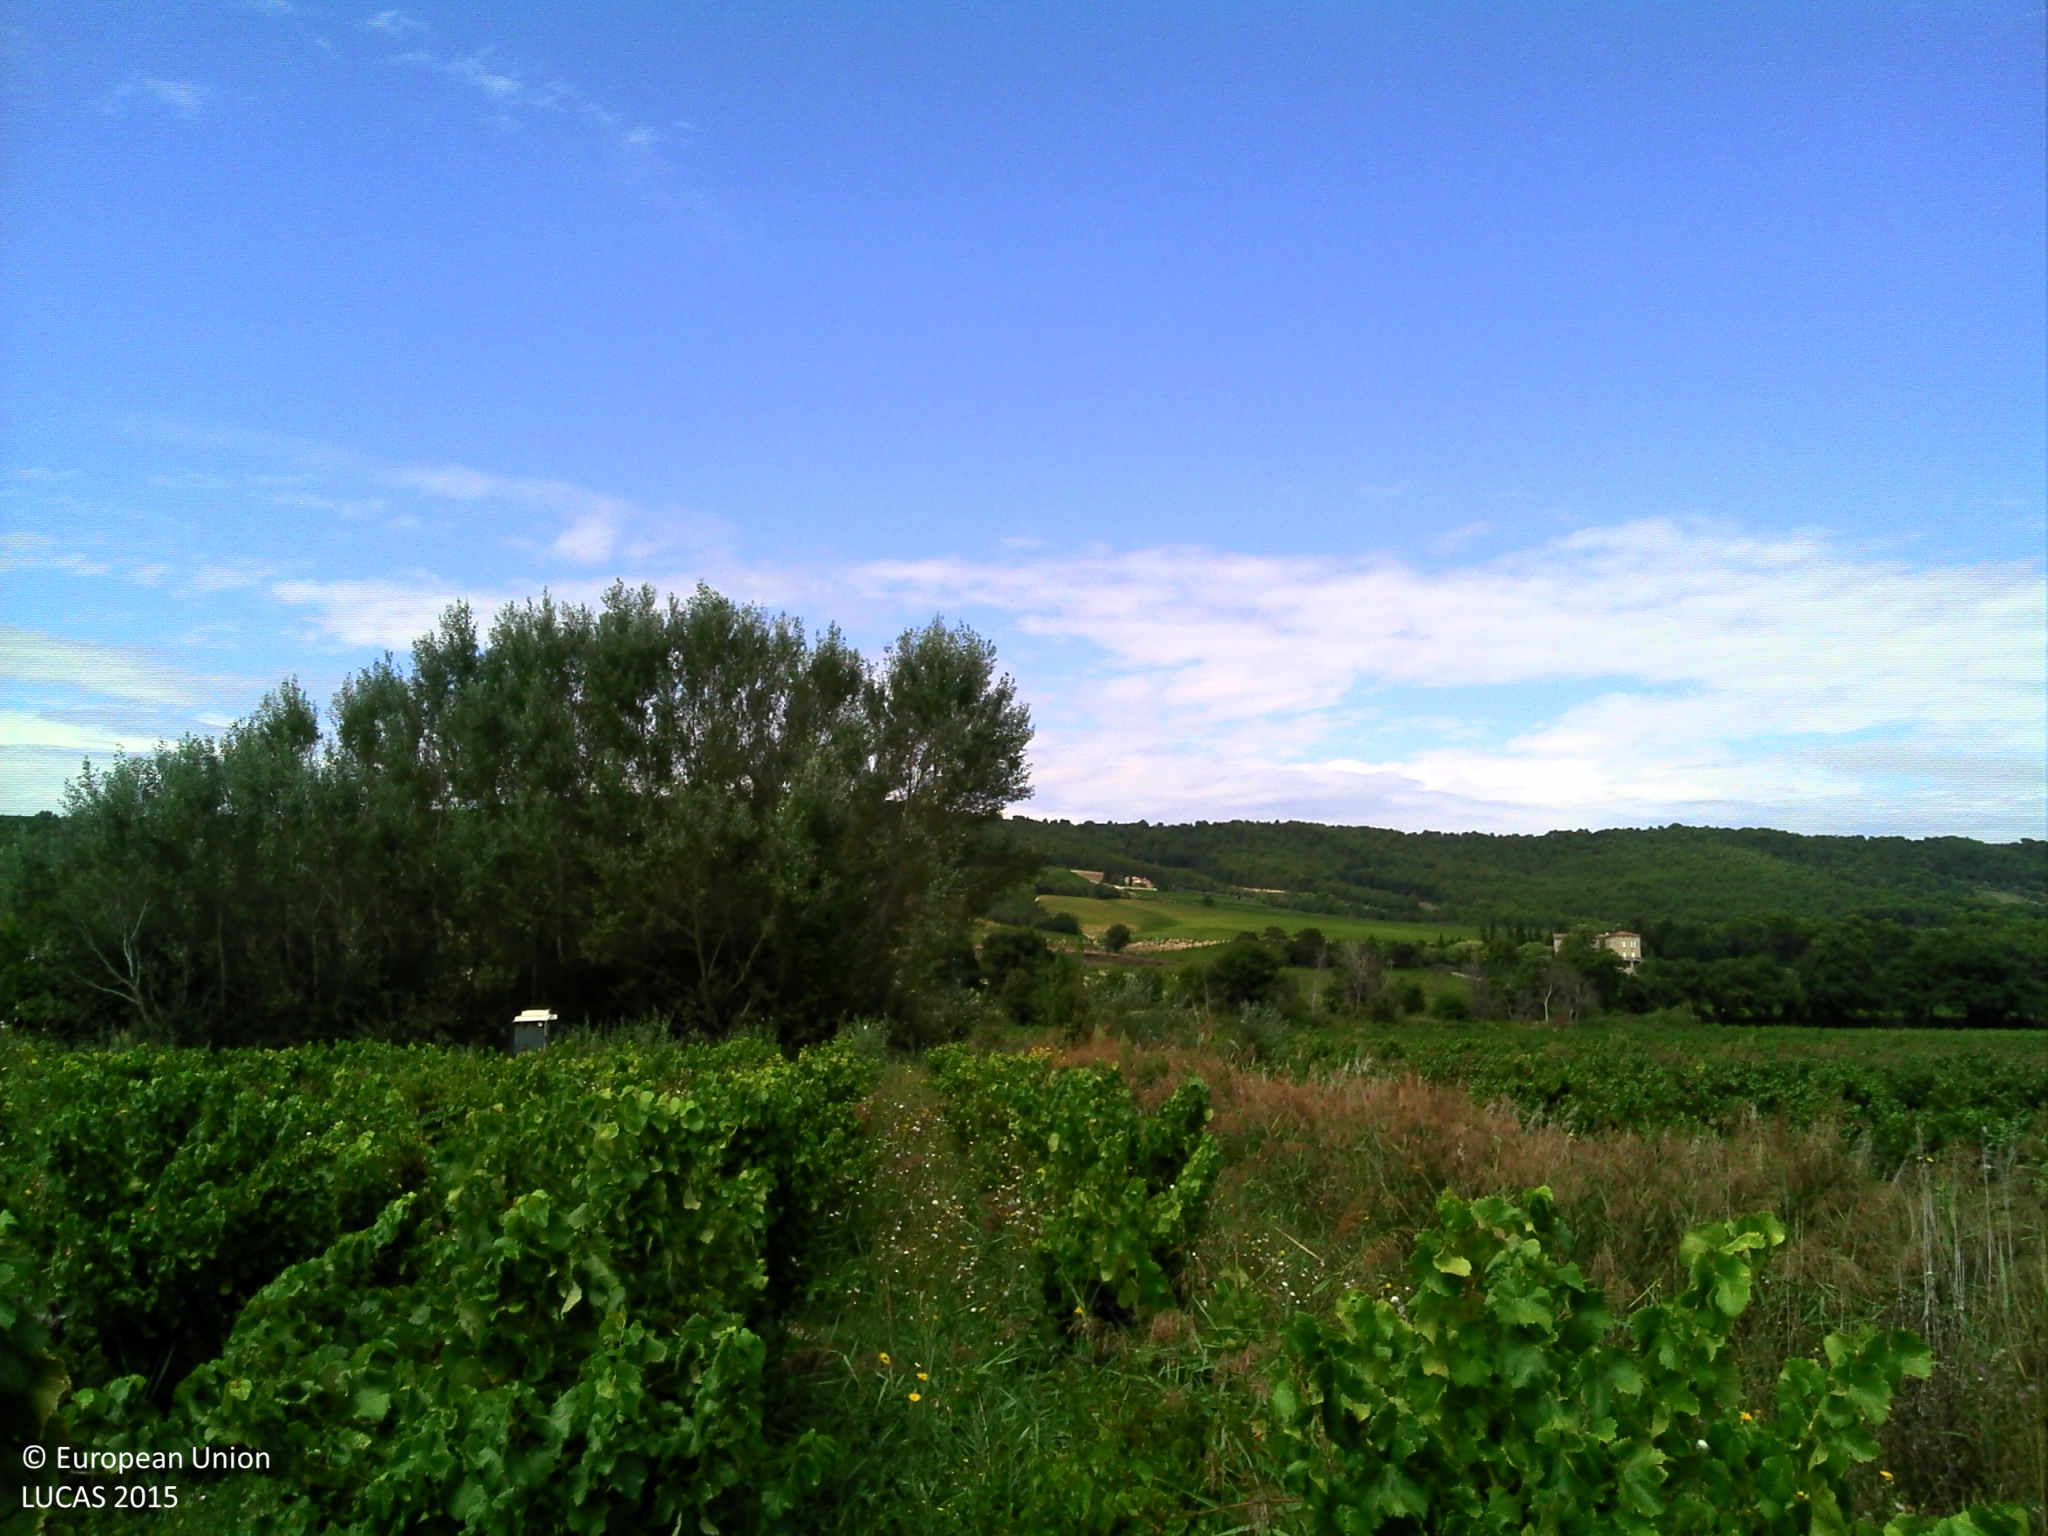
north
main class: Cropland
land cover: Vineyards
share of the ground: 10 - 25 %
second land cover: Grassland without tree/shrub cover
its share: > 75 %
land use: Agriculture (excluding fallow land and kitchen gardens)
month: September
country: FR
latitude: 44.3038
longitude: 5.0311
